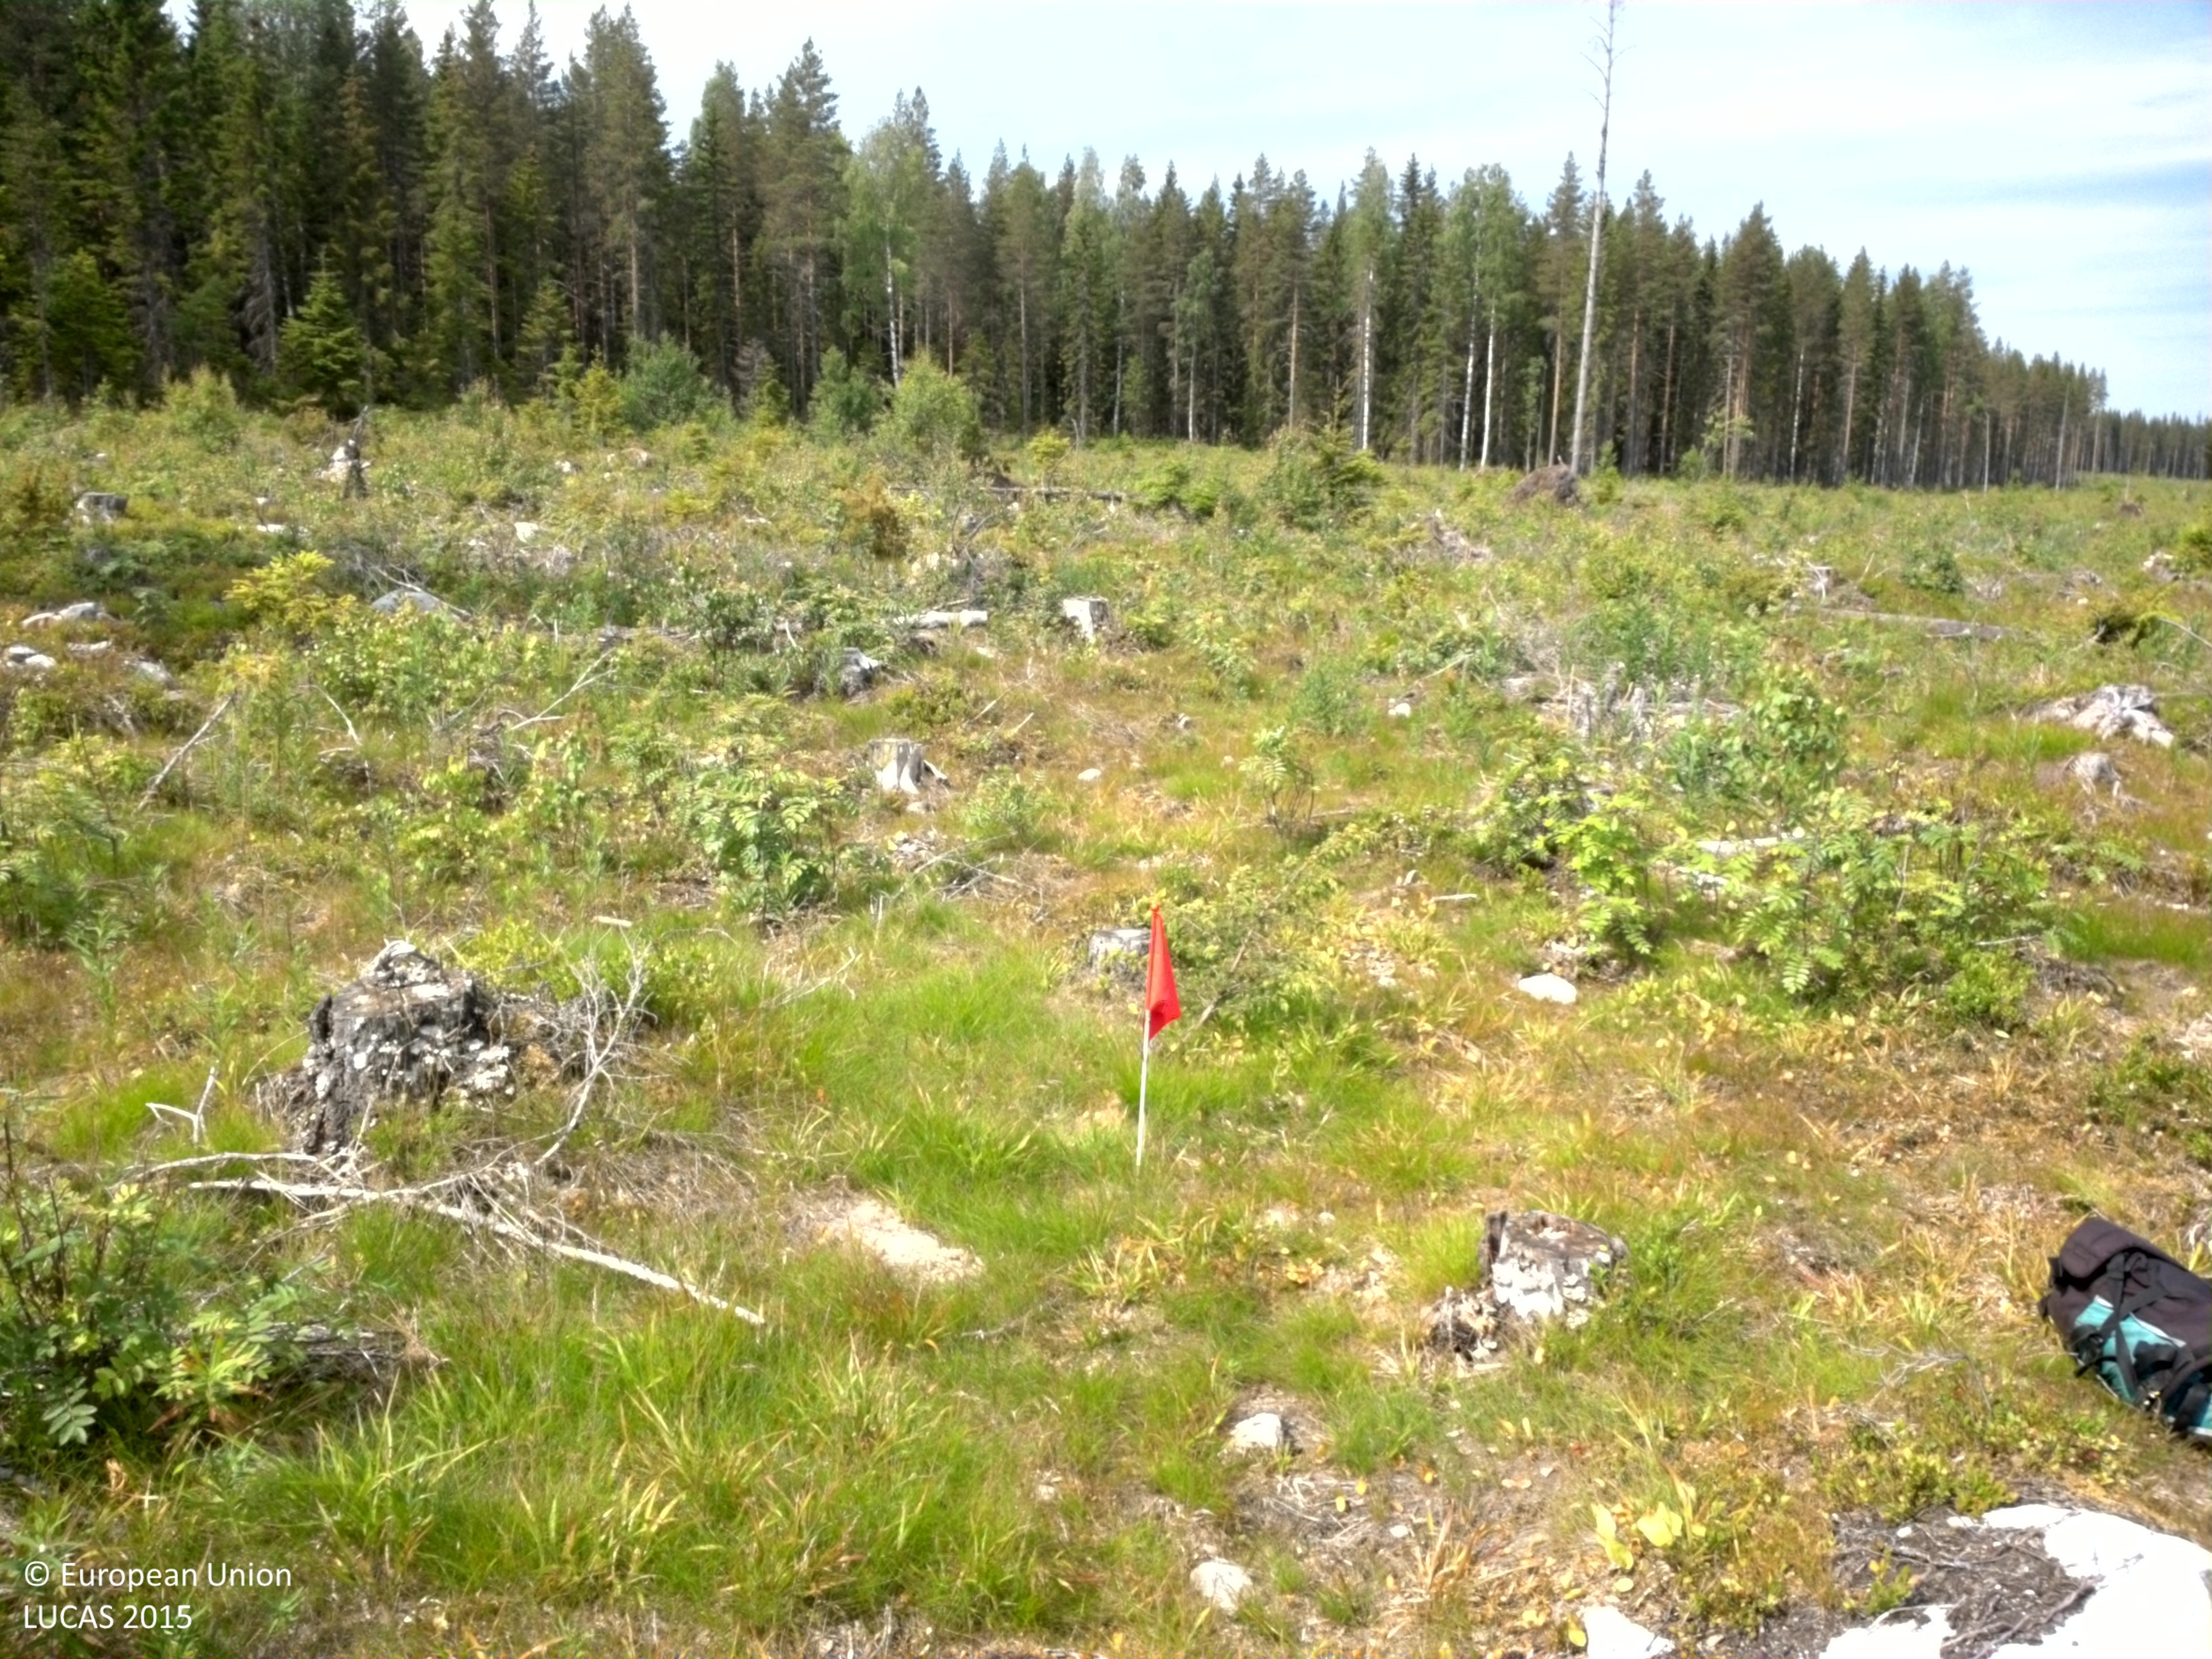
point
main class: Grassland
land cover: Grassland with sparse tree/shrub cover
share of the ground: > 75 %
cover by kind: herbaceous plants 75 %, shrubs 10 %, unconsolidated bare surface 10 %, broadleaved forest trees 5 %
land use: Forestry
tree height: > 5 m
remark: Clear cut
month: July
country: SE
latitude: 64.4400
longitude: 20.9283
